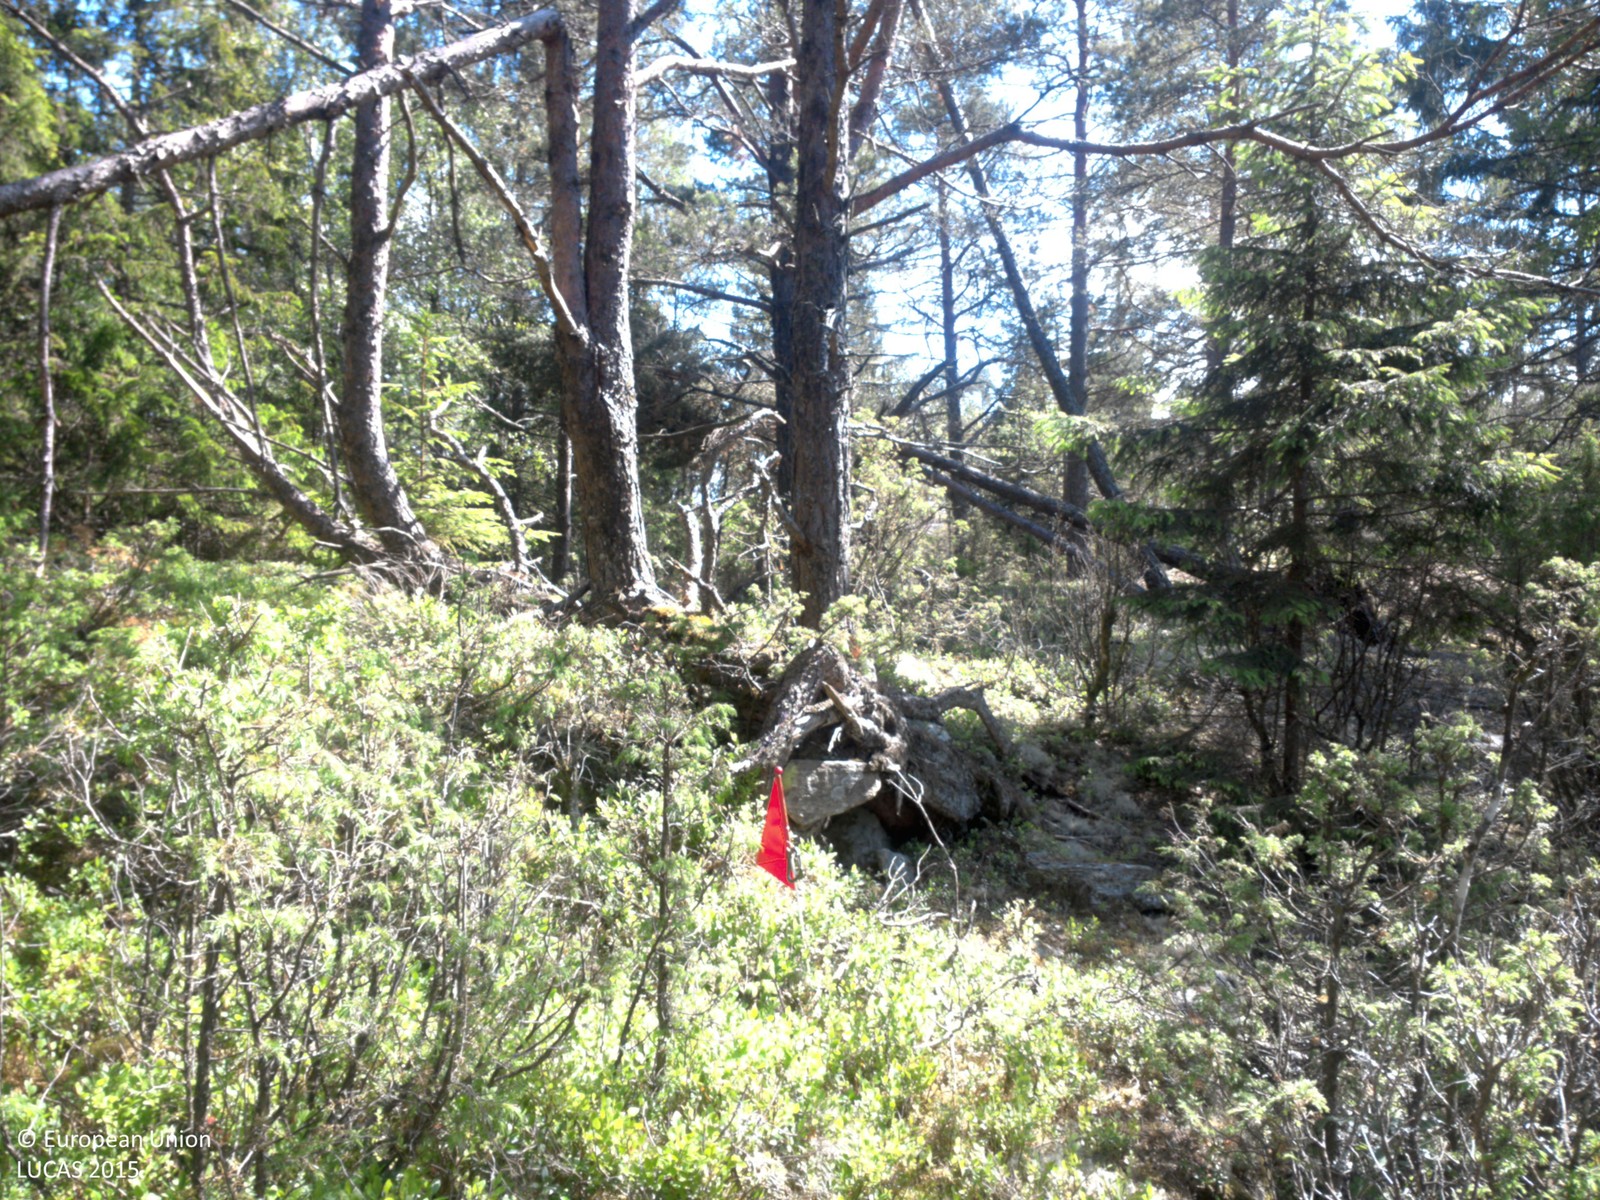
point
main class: Woodland
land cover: Pine dominated coniferous woodland
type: boreal forest
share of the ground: 50 - 75 %
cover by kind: coniferous forest trees 50 %, lichens and mosses 40 %, shrubs 10 %
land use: Forestry
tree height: > 5 m
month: June
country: SE
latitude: 58.6066
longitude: 11.5285
